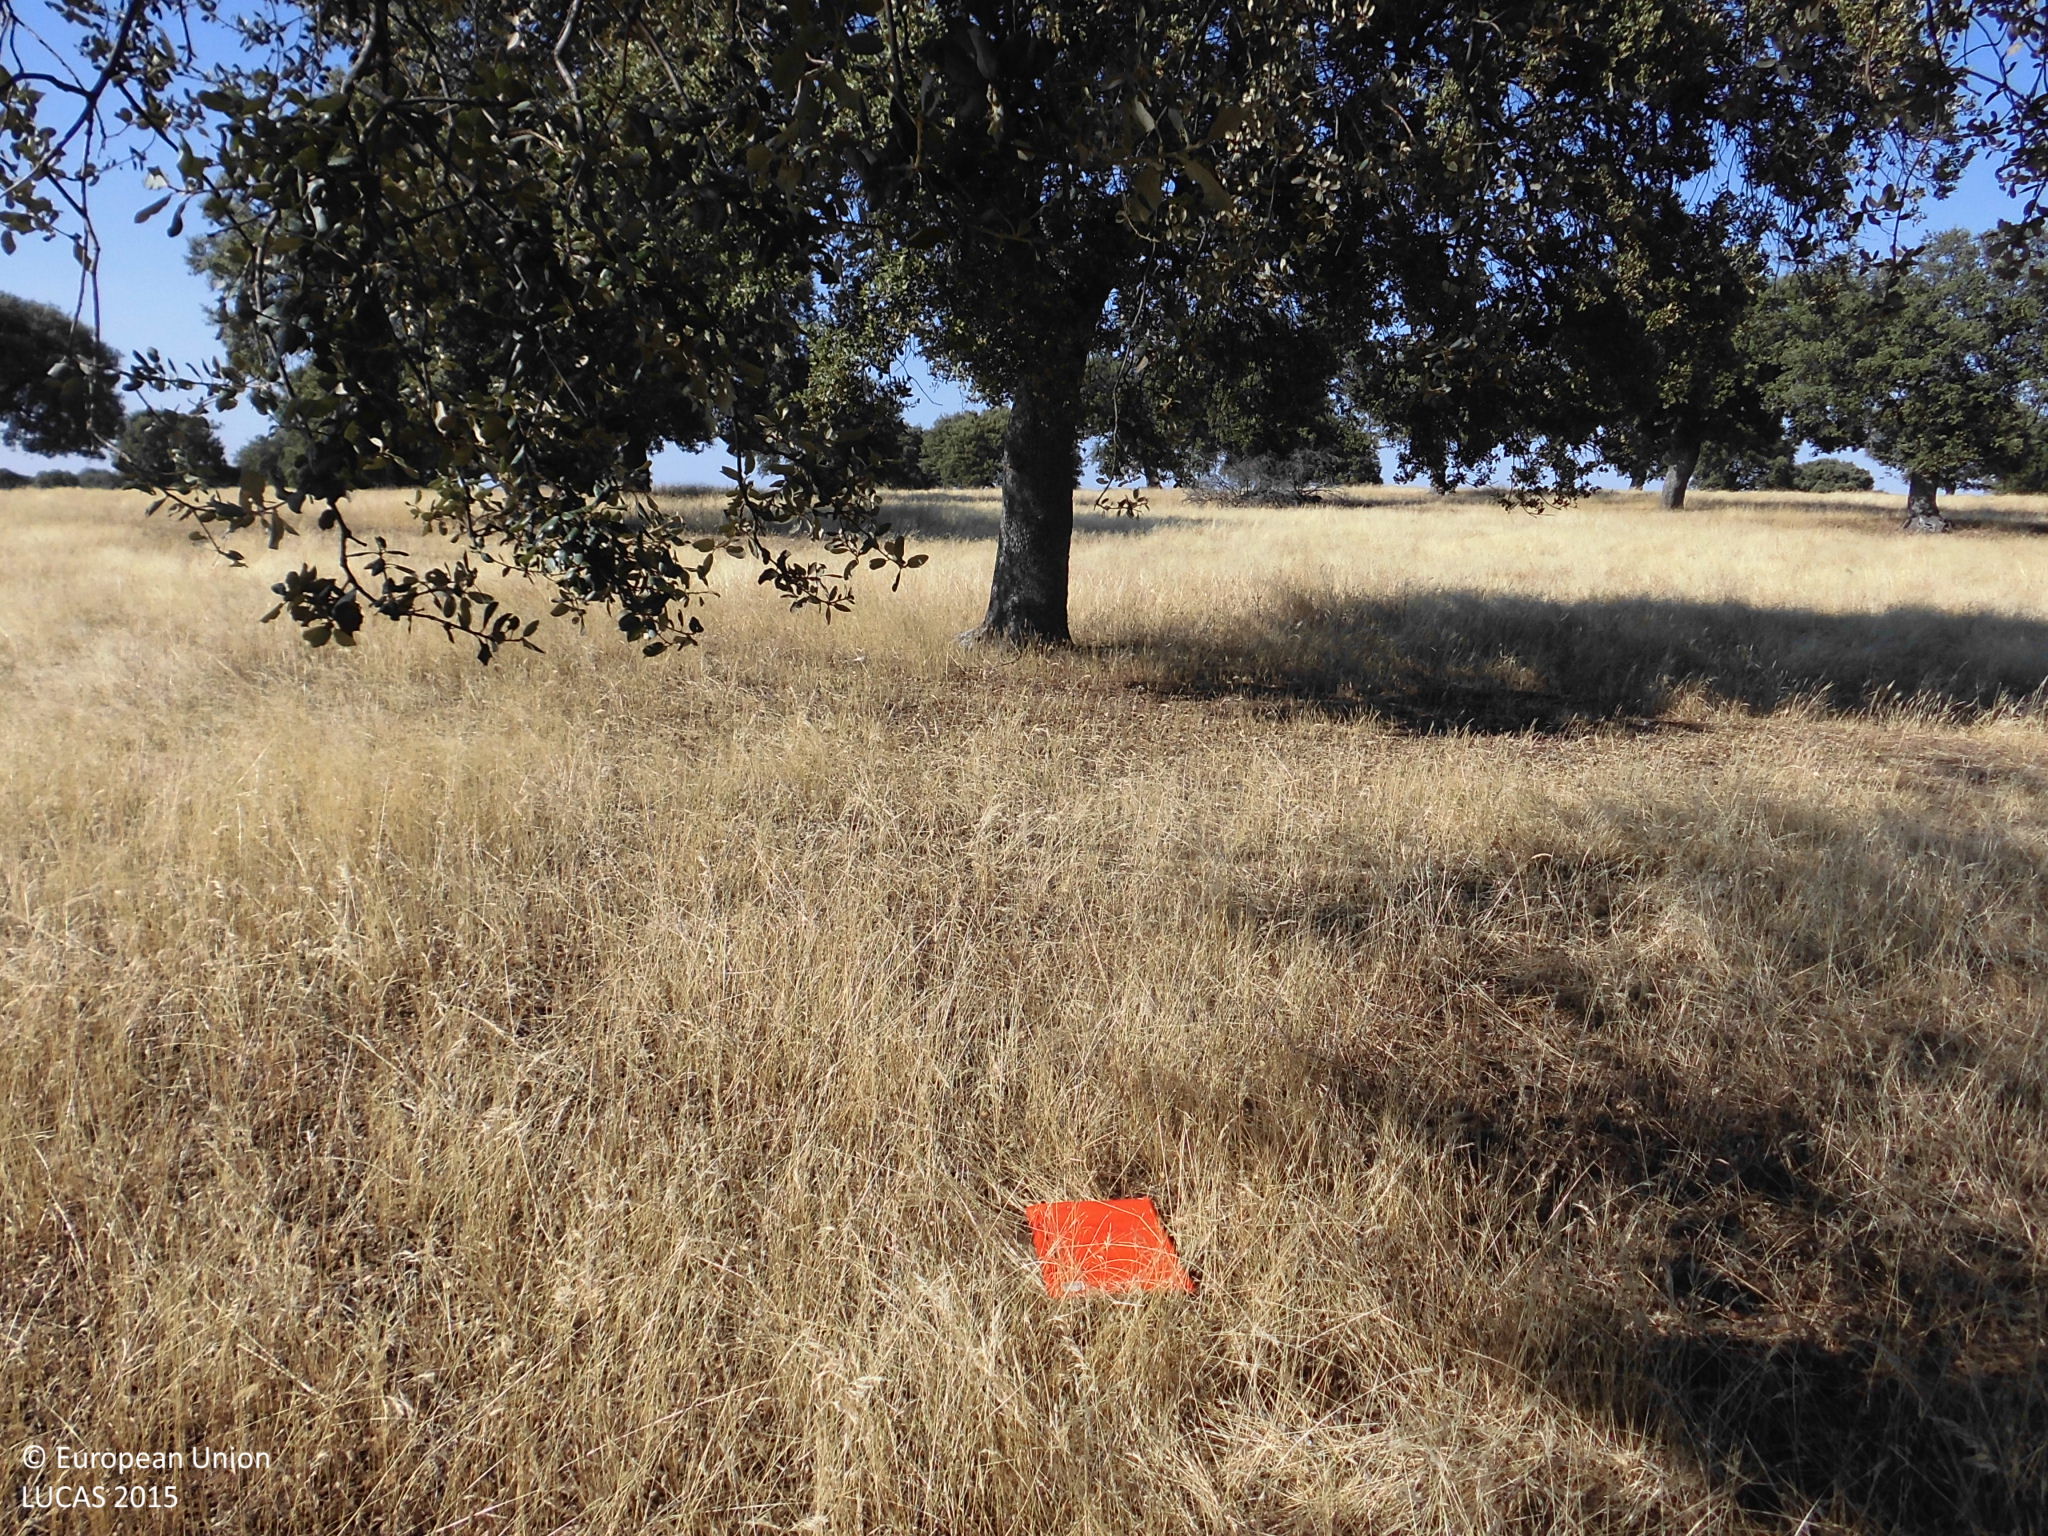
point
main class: Woodland
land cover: Broadleaved woodland
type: broadleaved evergreen forest
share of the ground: 10 - 25 %
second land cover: Grassland without tree/shrub cover
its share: > 75 %
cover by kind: herbaceous plants 85 %, broadleaved forest trees 15 %
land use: Forestry
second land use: Agriculture (excluding fallow land and kitchen gardens)
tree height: > 5 m
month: June
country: ES
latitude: 39.6451
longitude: -5.9932
